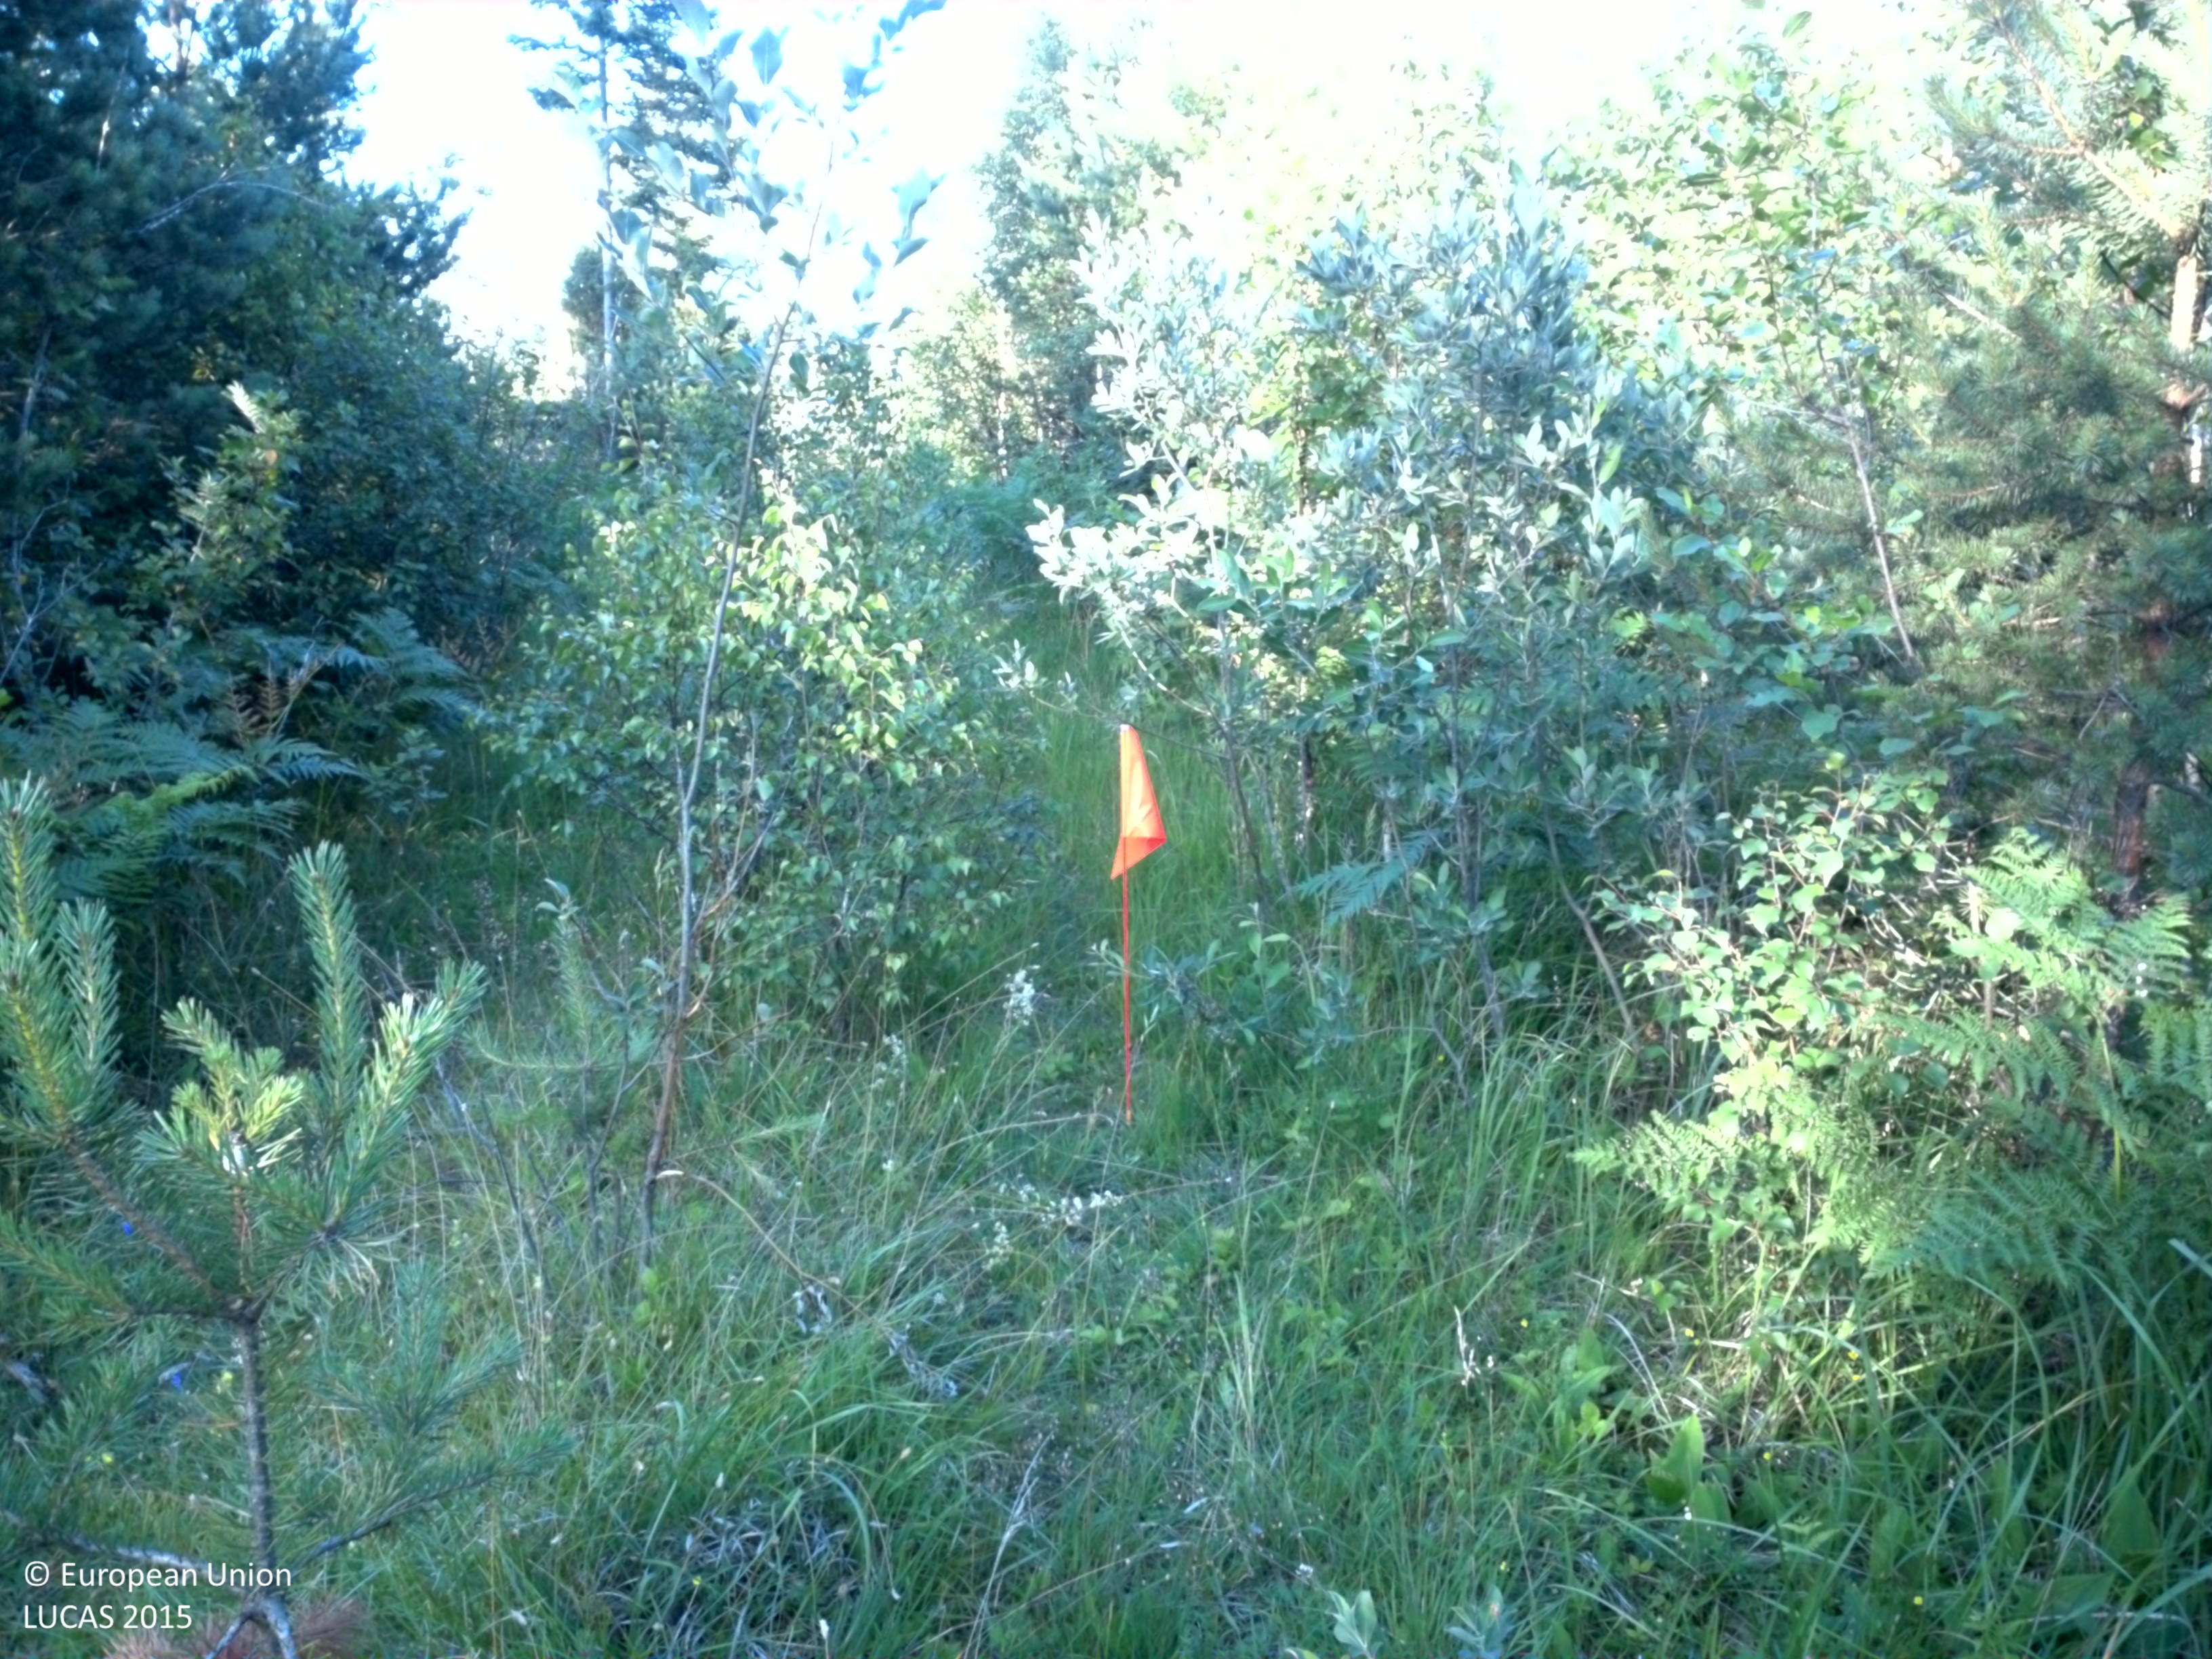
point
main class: Woodland
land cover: Other mixed woodland
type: hemiboreal forest and nemoral coniferous forest and mixed broadleaved-coniferous forest
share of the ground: > 75 %
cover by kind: broadleaved forest trees 35 %, coniferous forest trees 30 %, herbaceous plants 30 %, shrubs 5 %
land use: Forestry
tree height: < 5 m
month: July
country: SE
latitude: 57.4823
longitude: 18.7335
